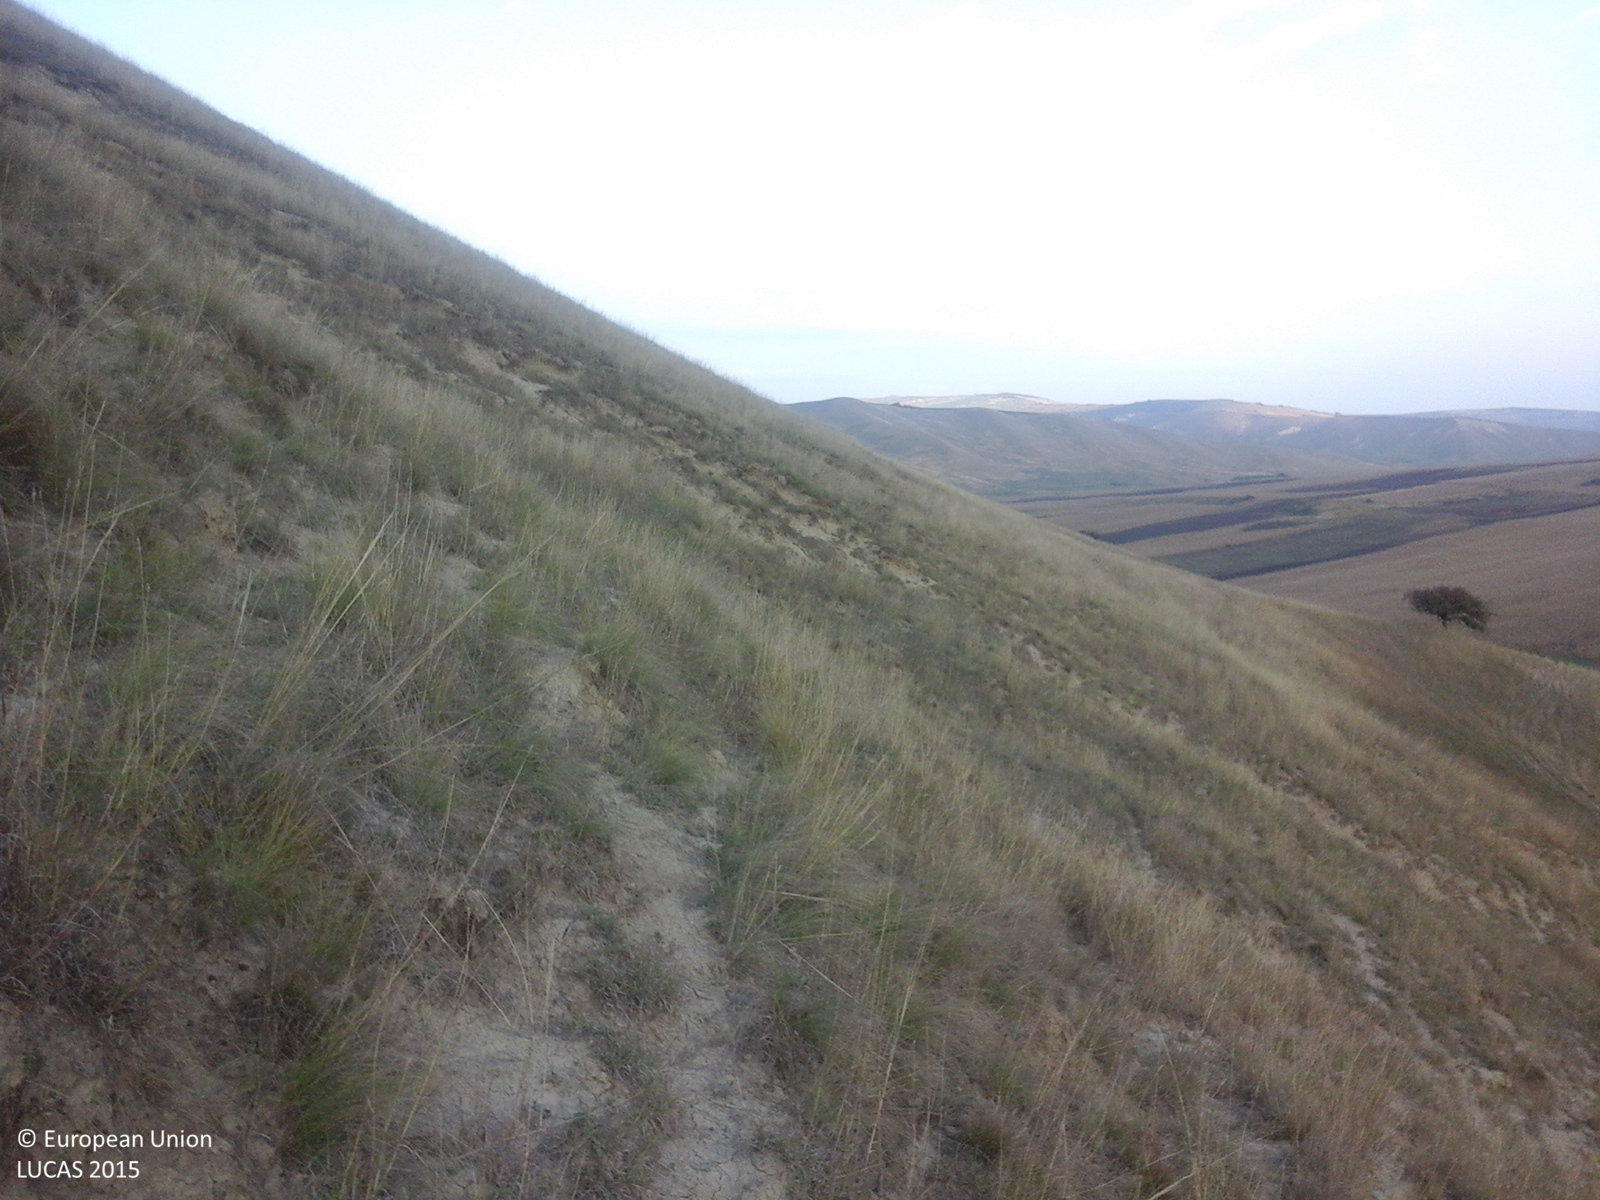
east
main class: Grassland
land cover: Grassland without tree/shrub cover
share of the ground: > 75 %
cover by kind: herbaceous plants 100 %
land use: Agriculture (excluding fallow land and kitchen gardens)
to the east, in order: Grassland without tree/shrub cover; Shrubland without tree cover; Grassland without tree/shrub cover
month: October
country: RO
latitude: 46.2582
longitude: 23.9157
